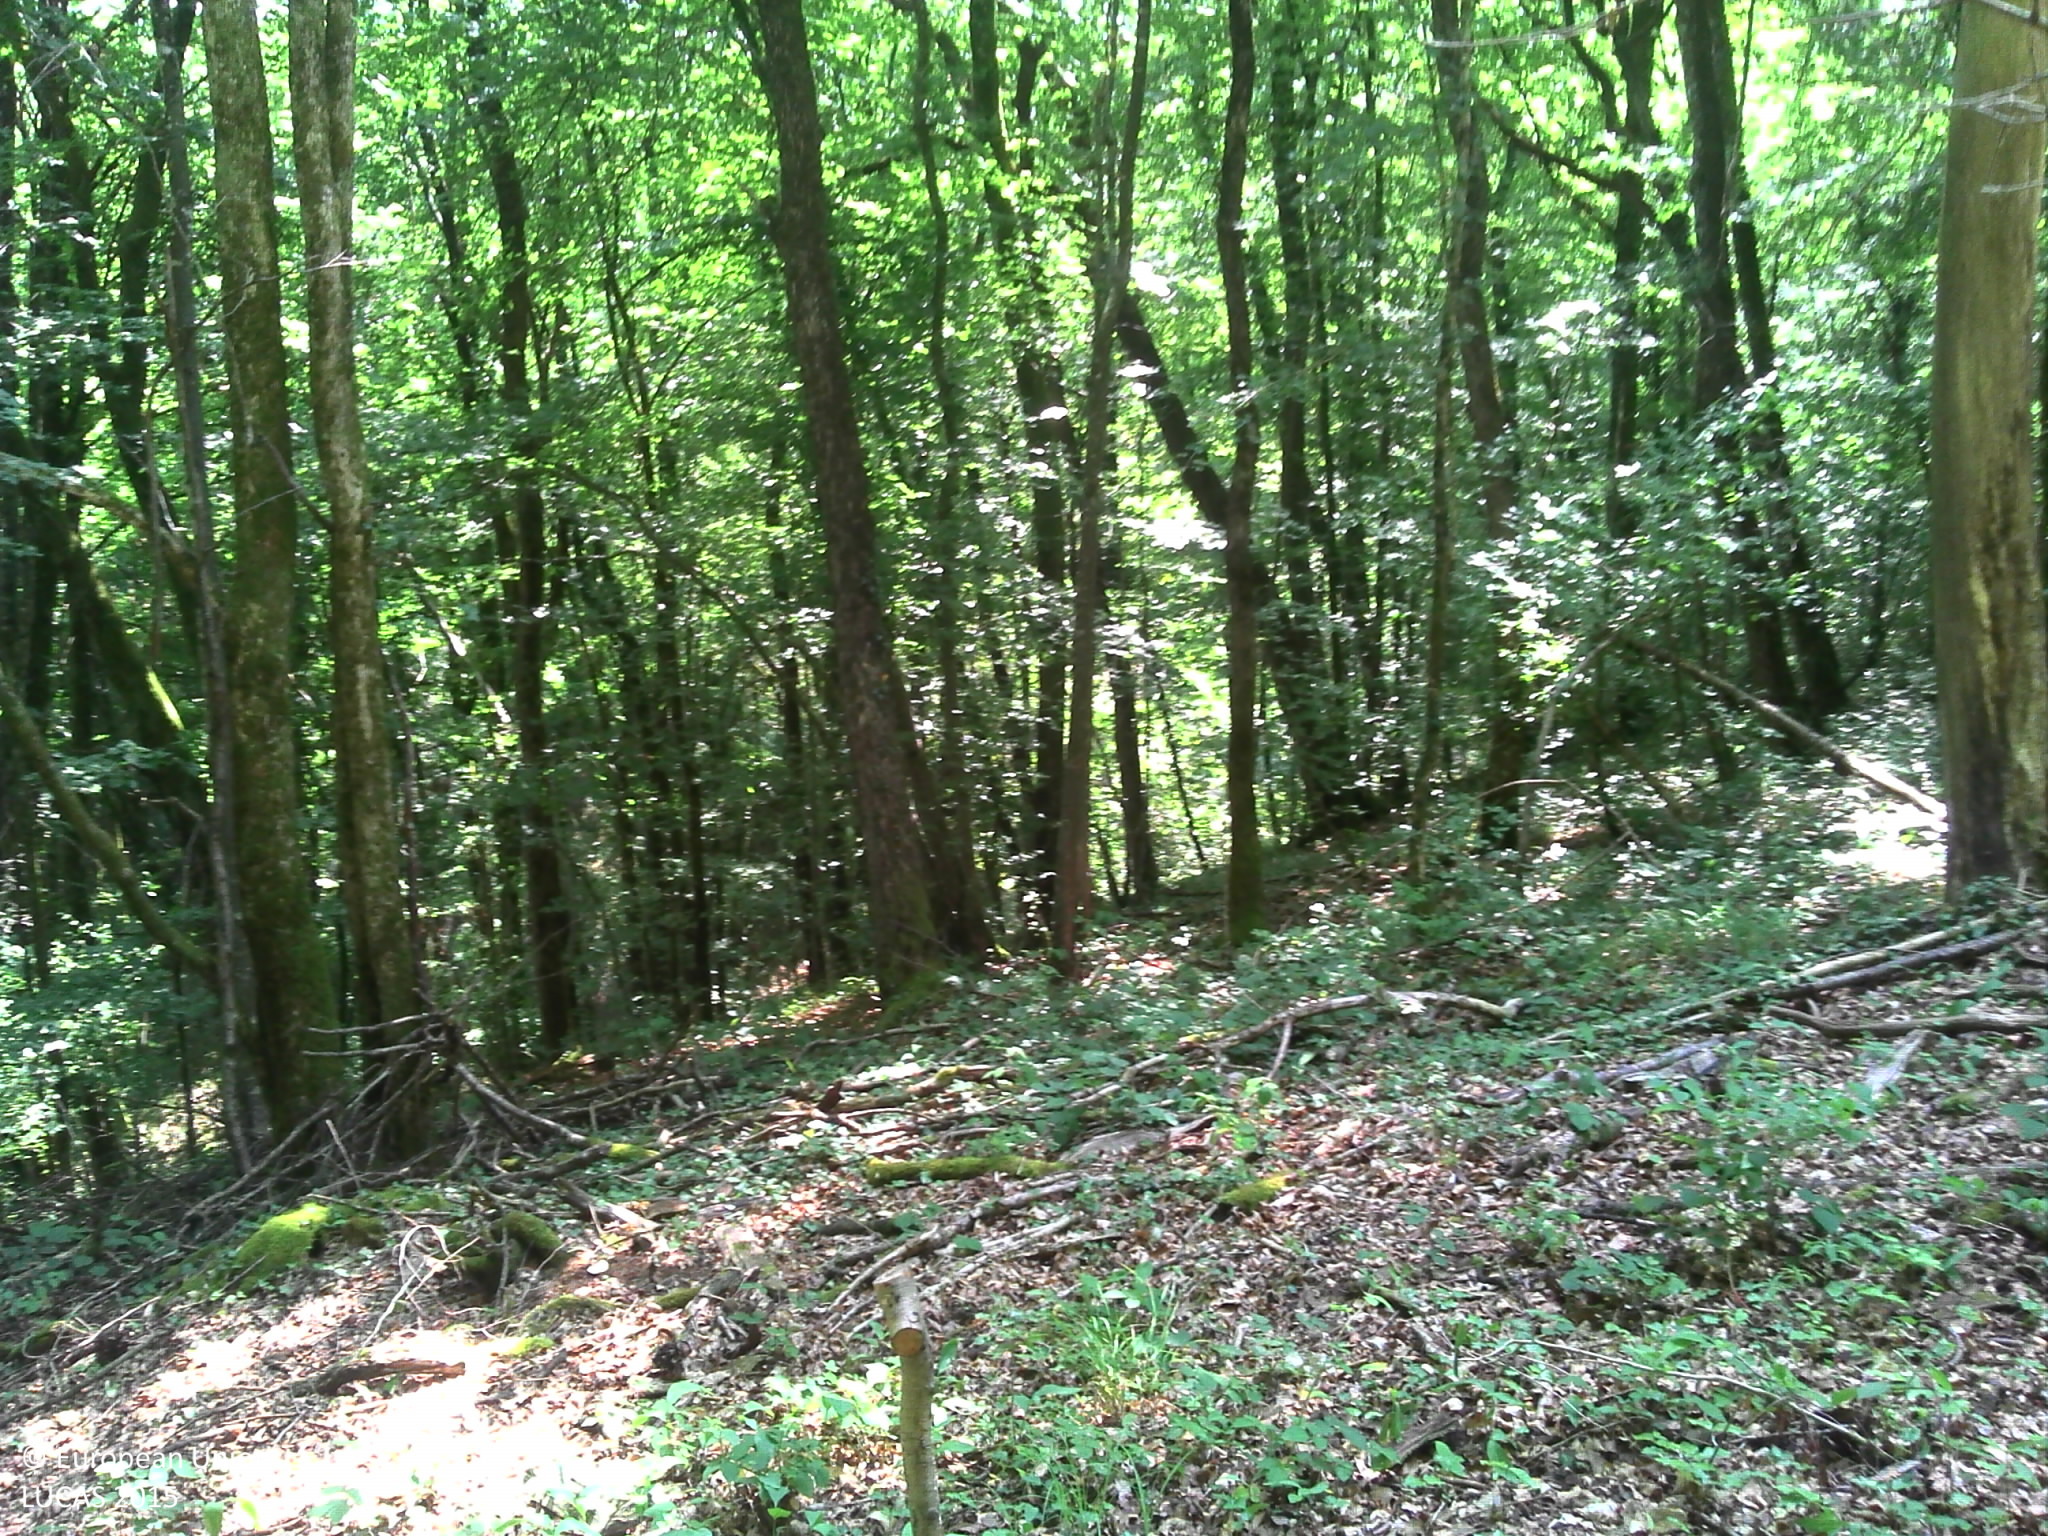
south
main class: Woodland
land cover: Broadleaved woodland
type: beech forest
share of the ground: > 75 %
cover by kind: broadleaved forest trees 85 %, lichens and mosses 10 %, herbaceous plants 5 %
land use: Forestry
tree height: > 5 m
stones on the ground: < 10 %
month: July
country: FR
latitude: 48.1214
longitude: 4.8534
